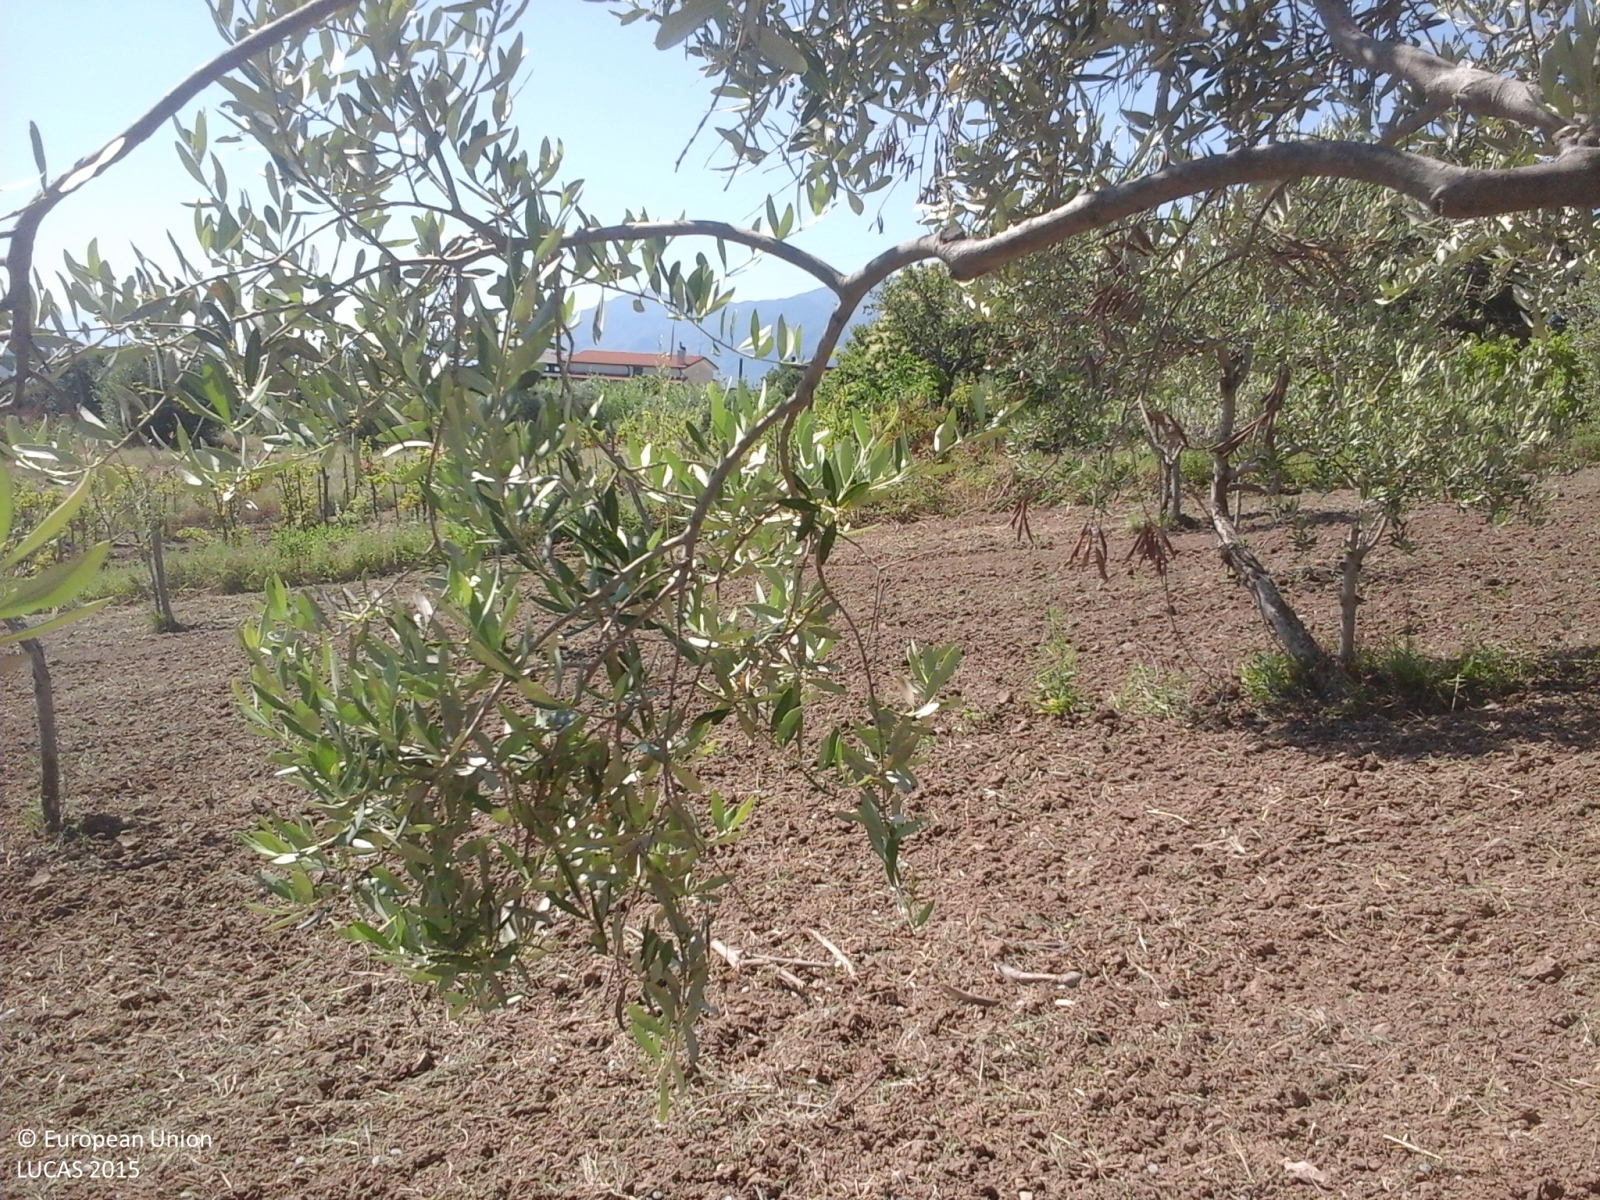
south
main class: Cropland
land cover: Olive groves
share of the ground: 50 - 75 %
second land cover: Other bare soil
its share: > 75 %
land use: Agriculture (excluding fallow land and kitchen gardens)
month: July
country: IT
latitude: 41.0807
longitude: 14.6599
